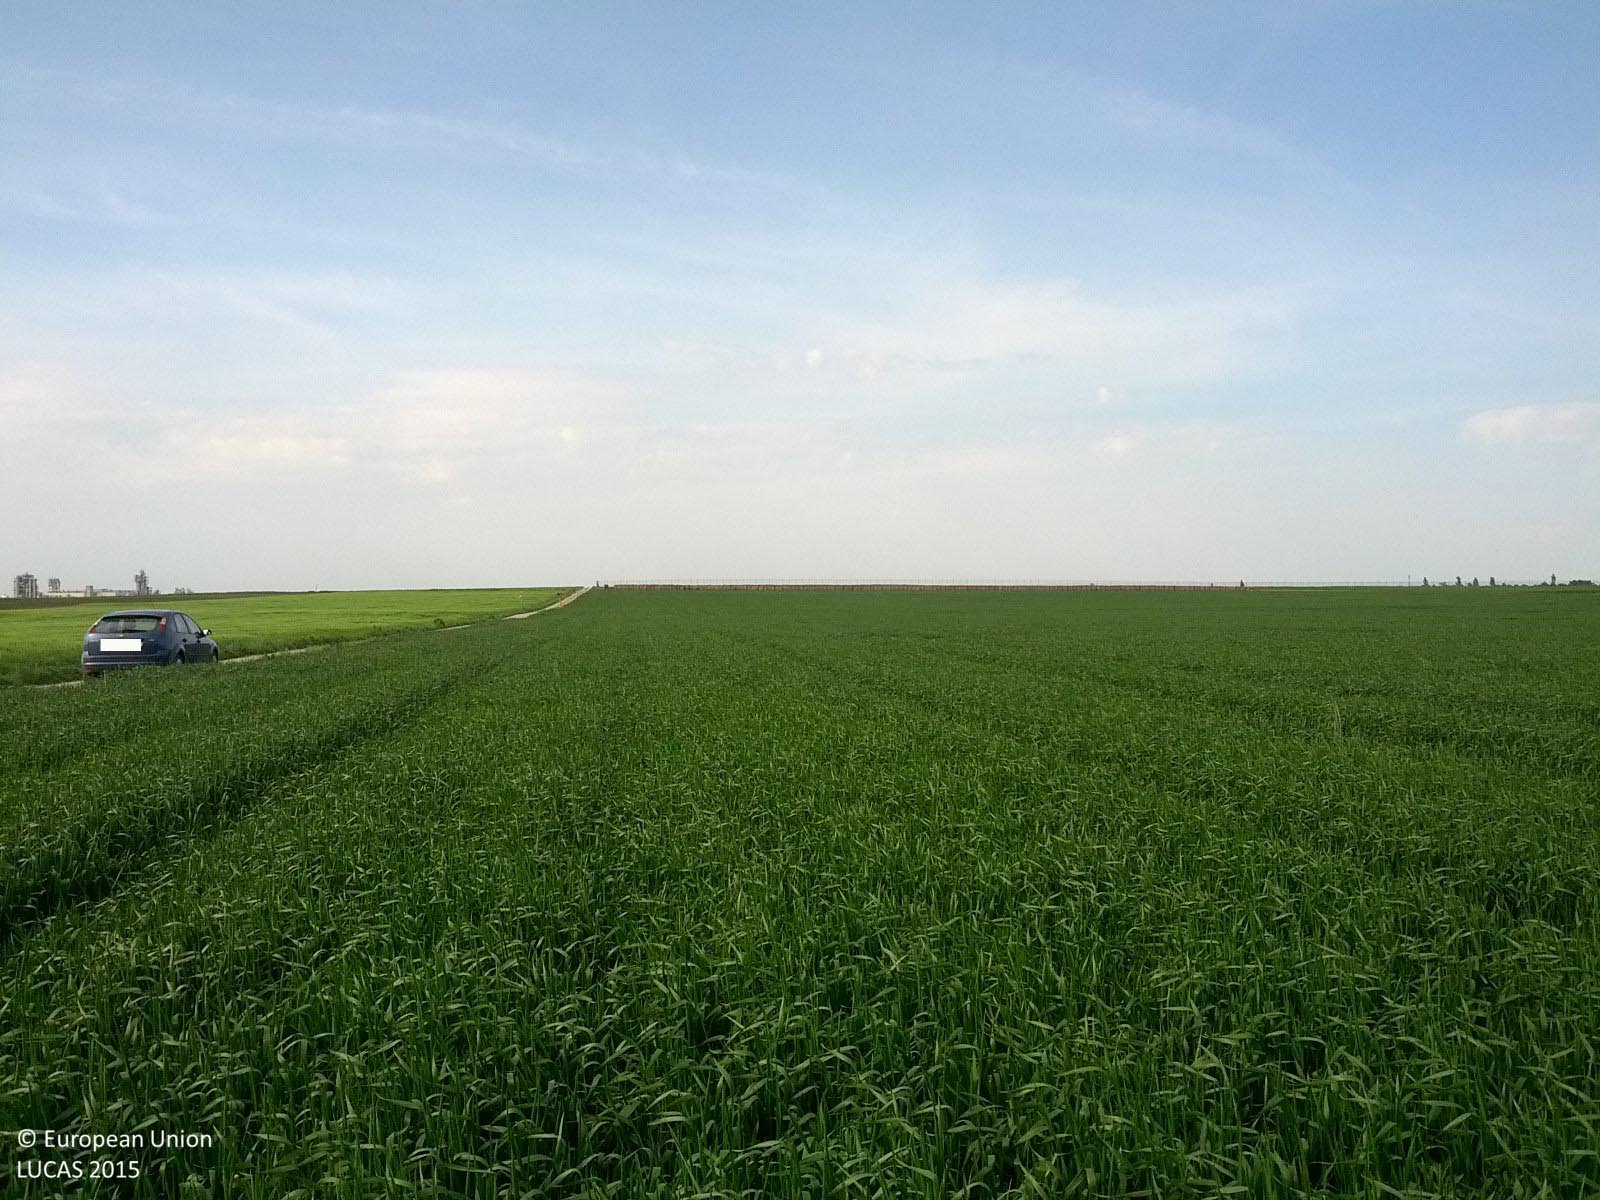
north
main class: Cropland
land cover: Triticale
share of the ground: > 75 %
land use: Agriculture (excluding fallow land and kitchen gardens)
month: May
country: AT
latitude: 48.1207
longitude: 16.5208
